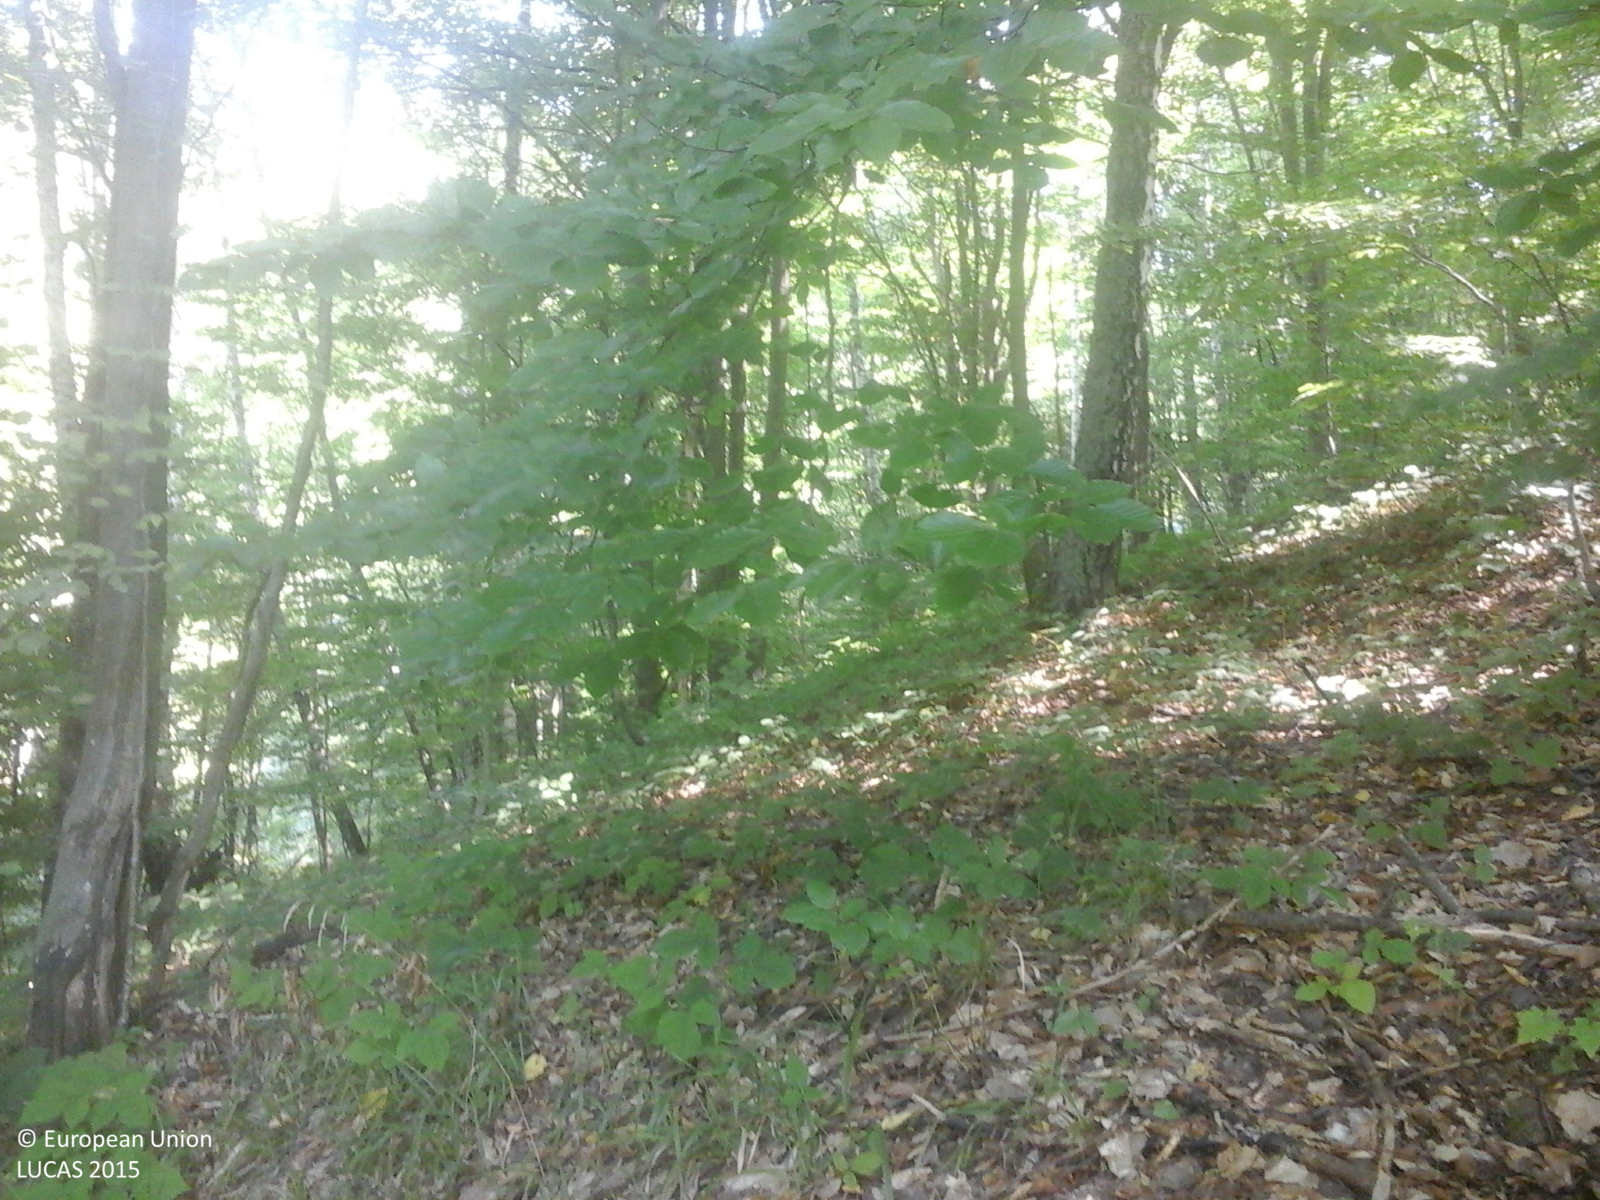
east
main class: Woodland
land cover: Broadleaved woodland
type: mesophytic deciduous forest
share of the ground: > 75 %
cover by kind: broadleaved forest trees 100 %
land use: Forestry
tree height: > 5 m
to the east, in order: Broadleaved woodland; Tracks; Broadleaved woodland
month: August
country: RO
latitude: 46.1471
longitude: 22.4648
